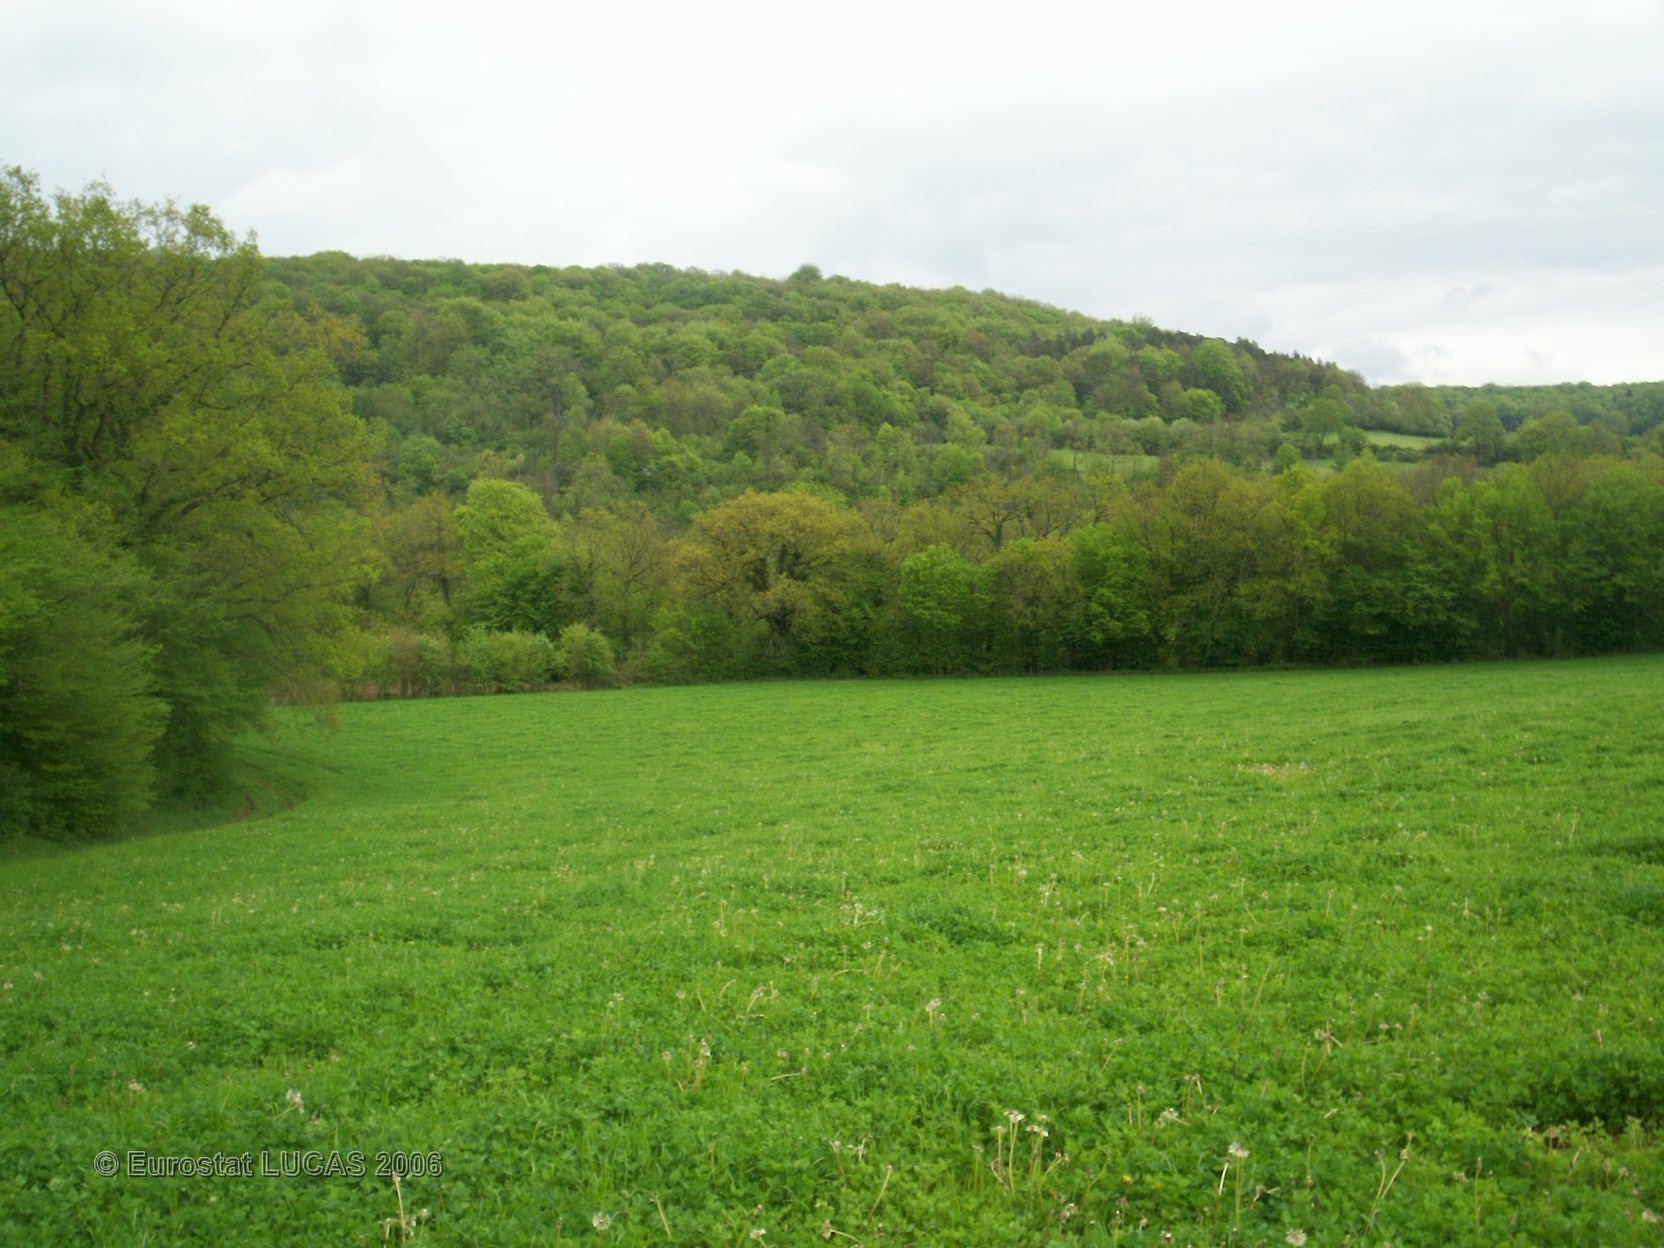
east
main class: Cropland
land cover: Clovers
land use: Agriculture (excluding fallow land and kitchen gardens)
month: May
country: FR
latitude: 47.7304
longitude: 4.5988
